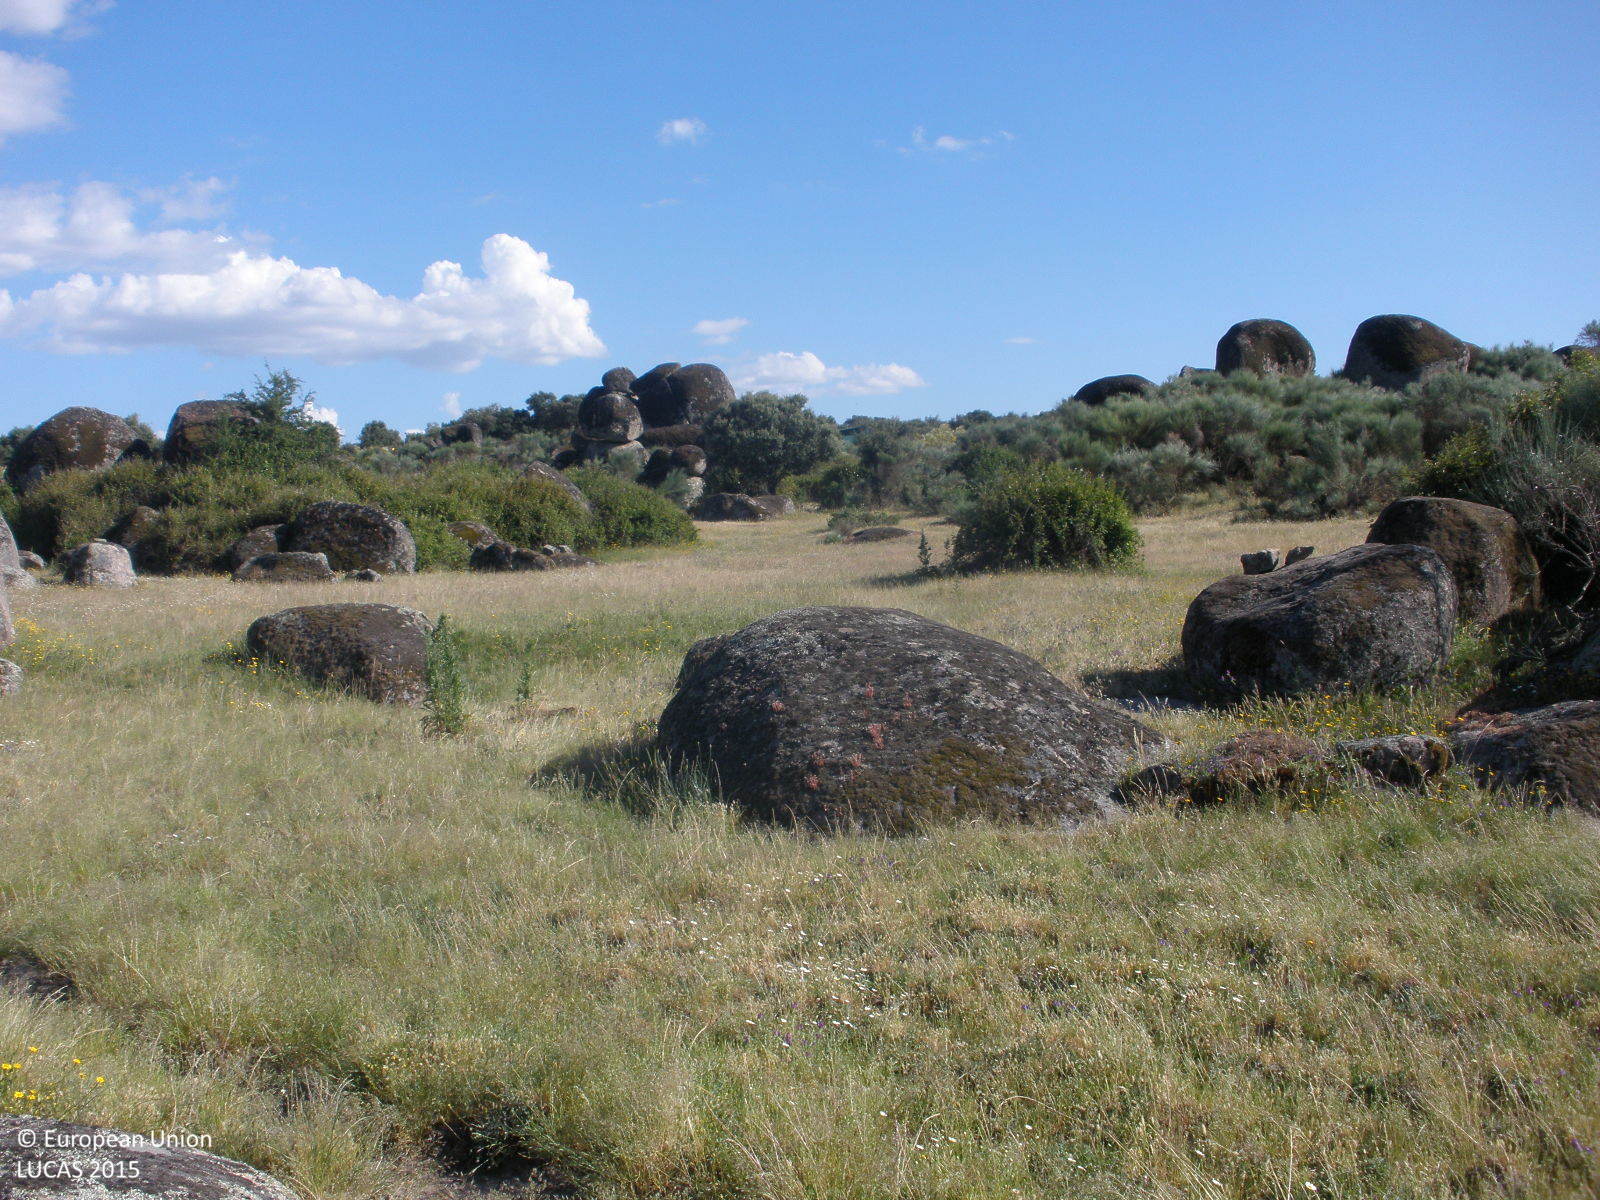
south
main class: Grassland
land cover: Grassland without tree/shrub cover
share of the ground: > 75 %
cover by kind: herbaceous plants 90 %, consolidated bare surface 10 %
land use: Agriculture (excluding fallow land and kitchen gardens)
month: May
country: ES
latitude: 40.1555
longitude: -6.2425
